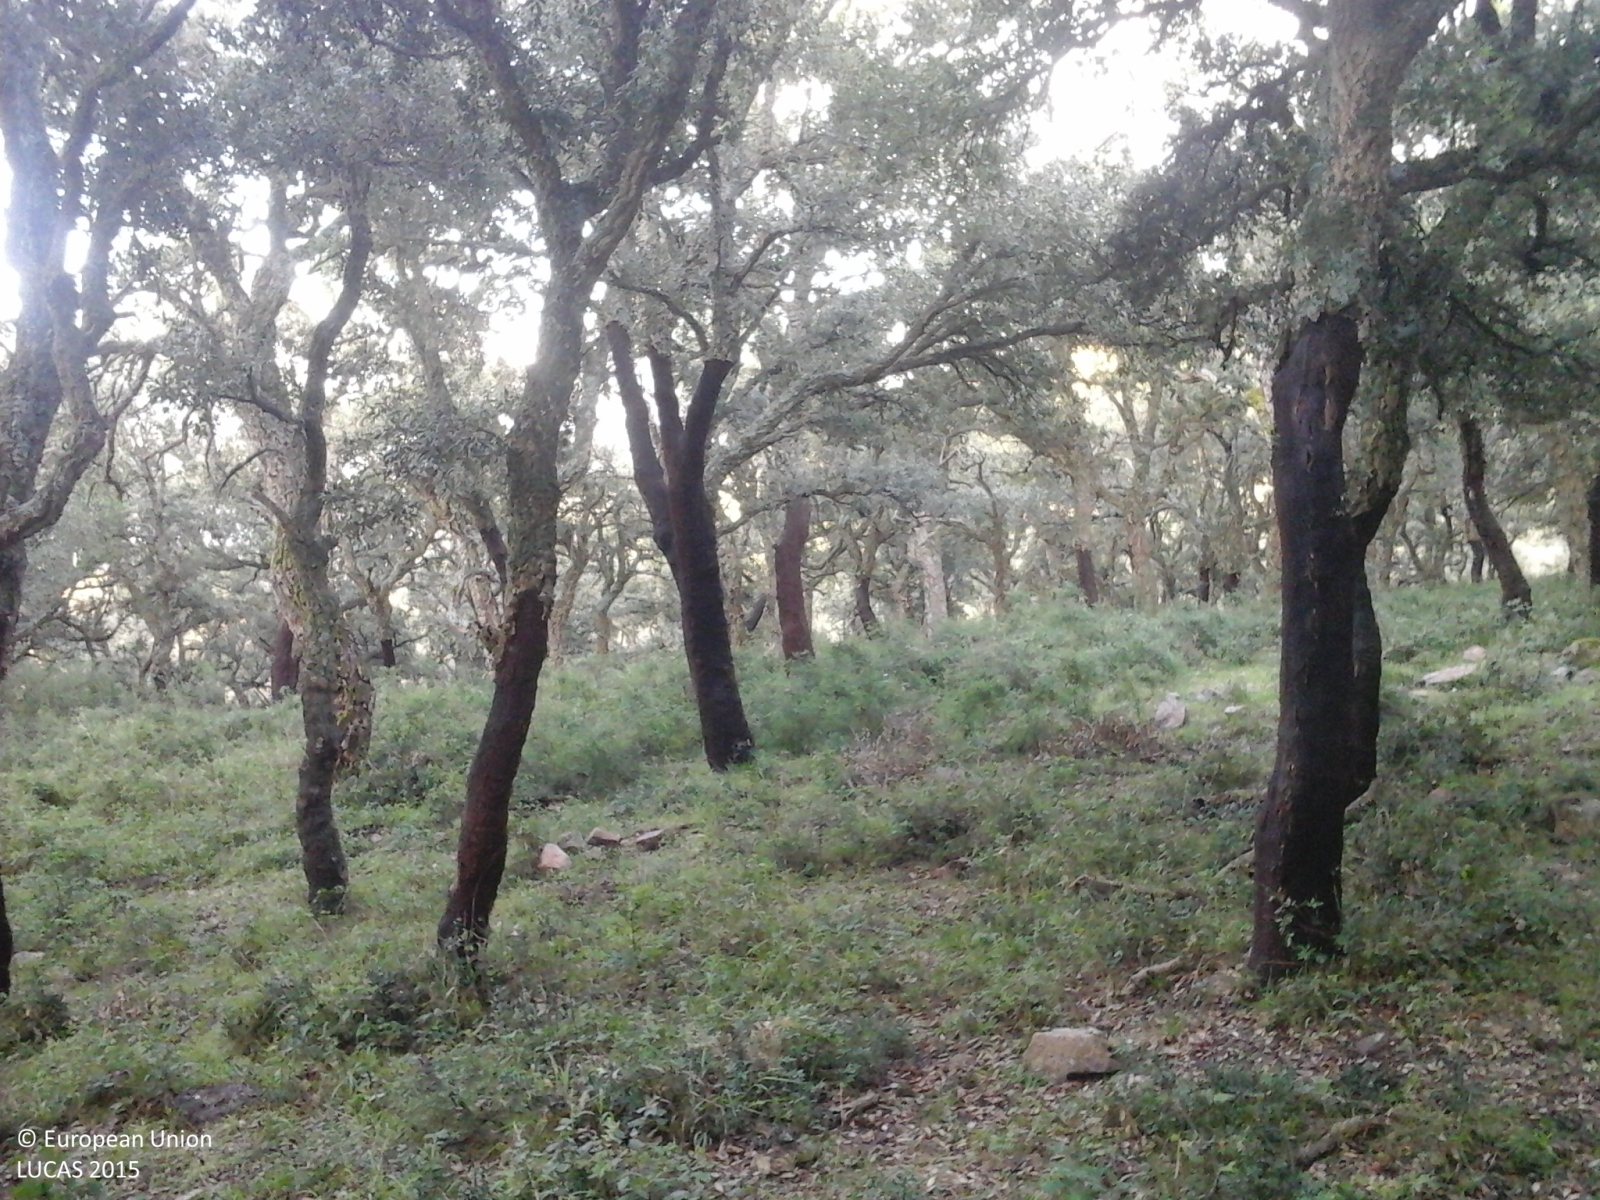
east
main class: Woodland
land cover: Broadleaved woodland
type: broadleaved evergreen forest
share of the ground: > 75 %
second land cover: Grassland without tree/shrub cover
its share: > 75 %
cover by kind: broadleaved forest trees 80 %, shrubs 10 %, herbaceous plants 5 %, consolidated bare surface 5 %
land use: Forestry
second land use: Agriculture (excluding fallow land and kitchen gardens)
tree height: > 5 m
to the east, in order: Broadleaved woodland; Grassland without tree/shrub cover; Fences; Broadleaved woodland; Grass margins; Paved roads, cycling and walking lanes; Grass margins; Broadleaved woodland; Fences; Broadleaved woodland; Rivers and streams; Broadleaved woodland; Tracks; Broadleaved woodland
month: May
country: IT
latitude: 37.8934
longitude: 14.1442
